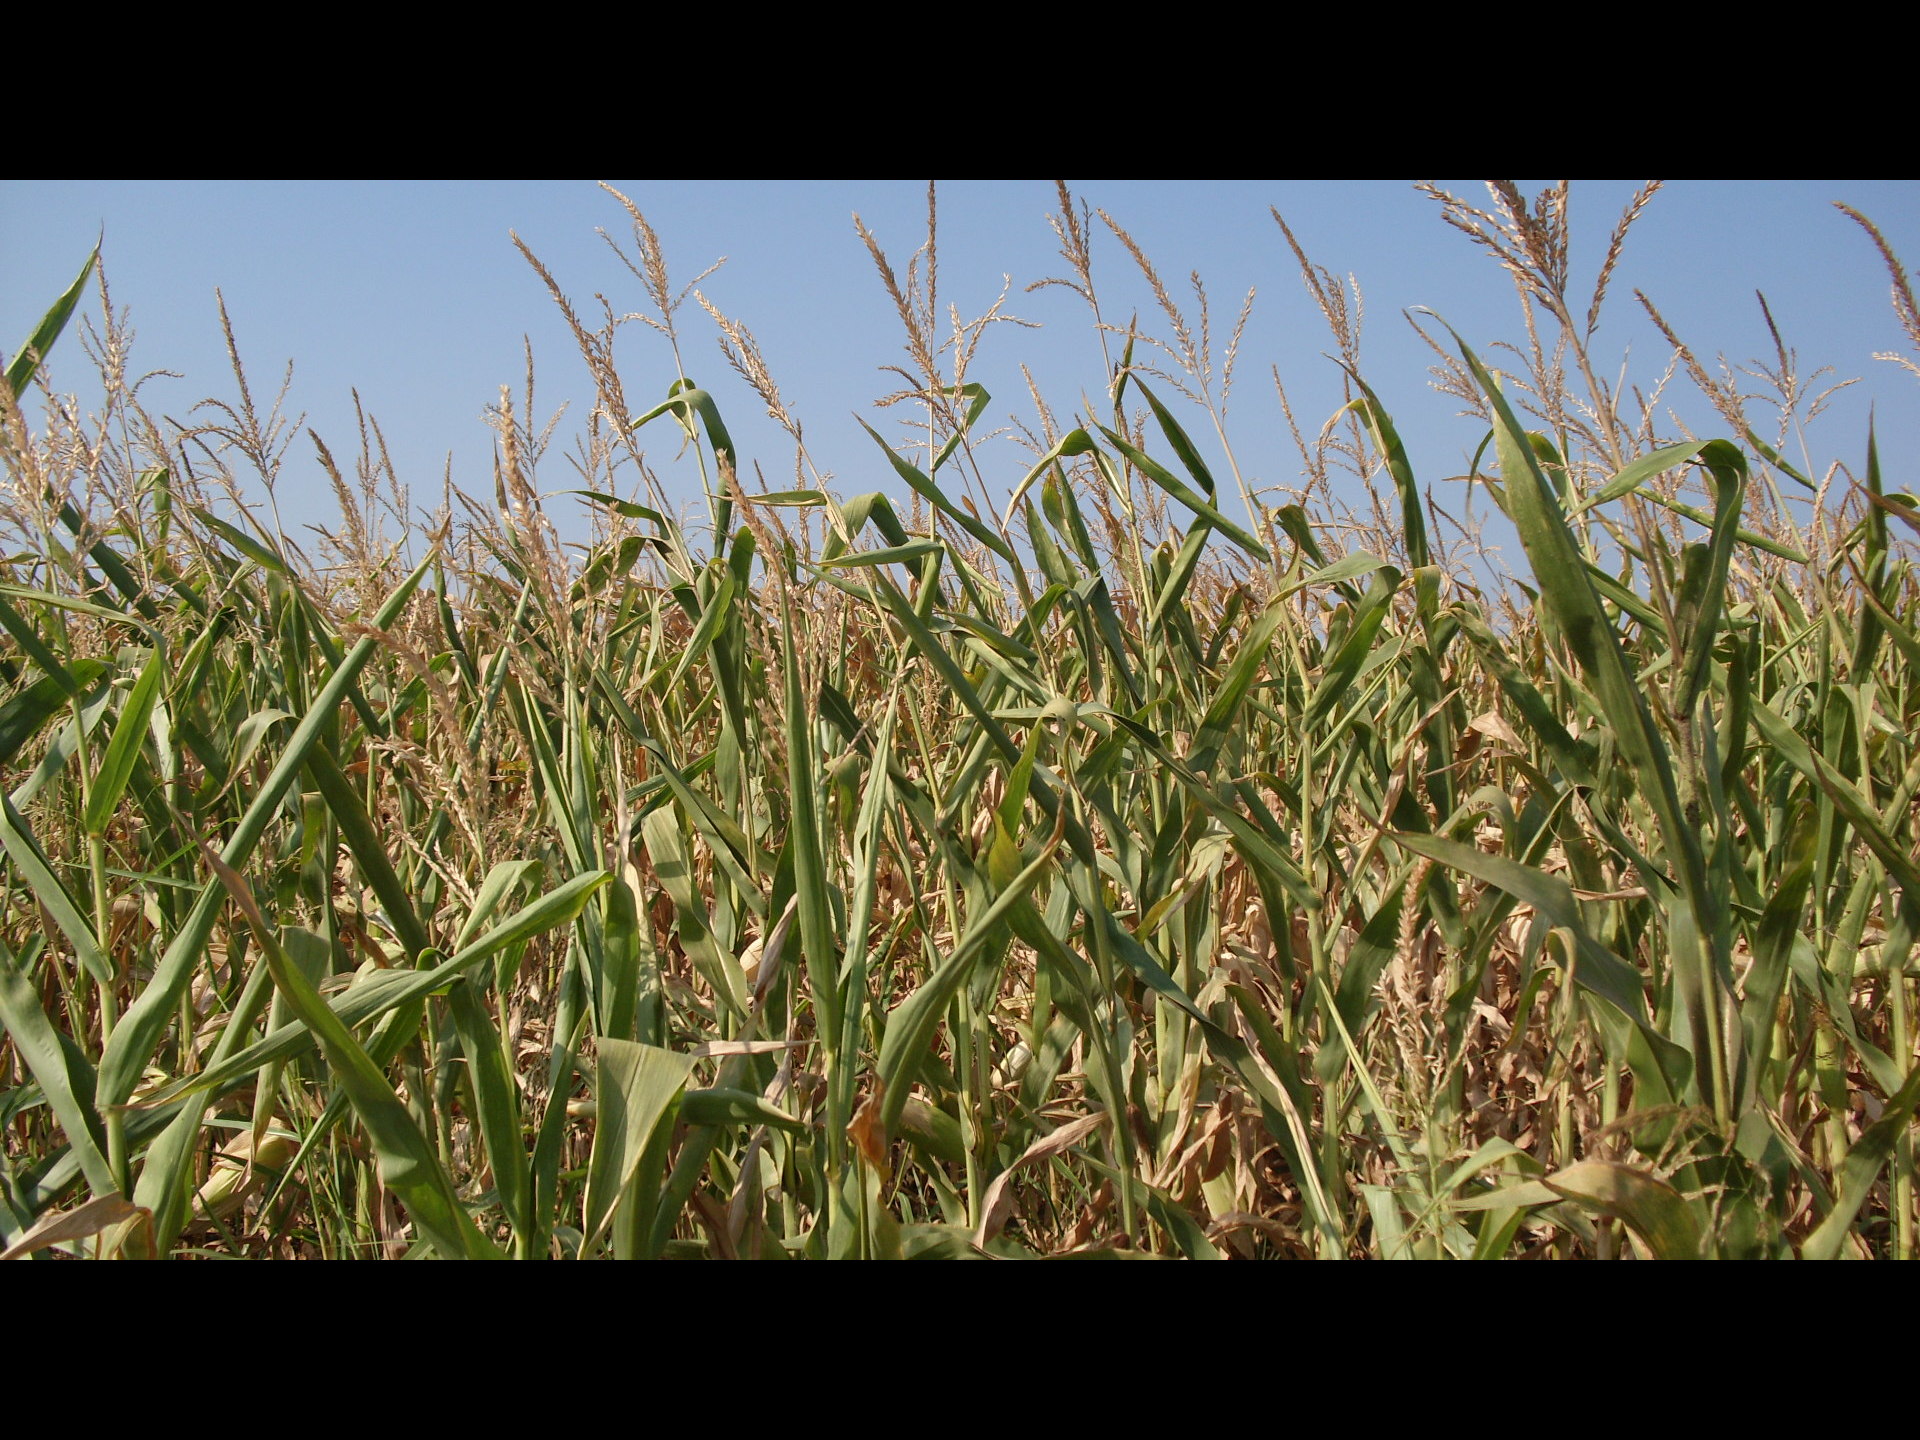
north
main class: Cropland
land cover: Maize
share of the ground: > 75 %
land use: Agriculture (excluding fallow land and kitchen gardens)
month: August
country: BG
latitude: 43.6738
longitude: 23.7053
